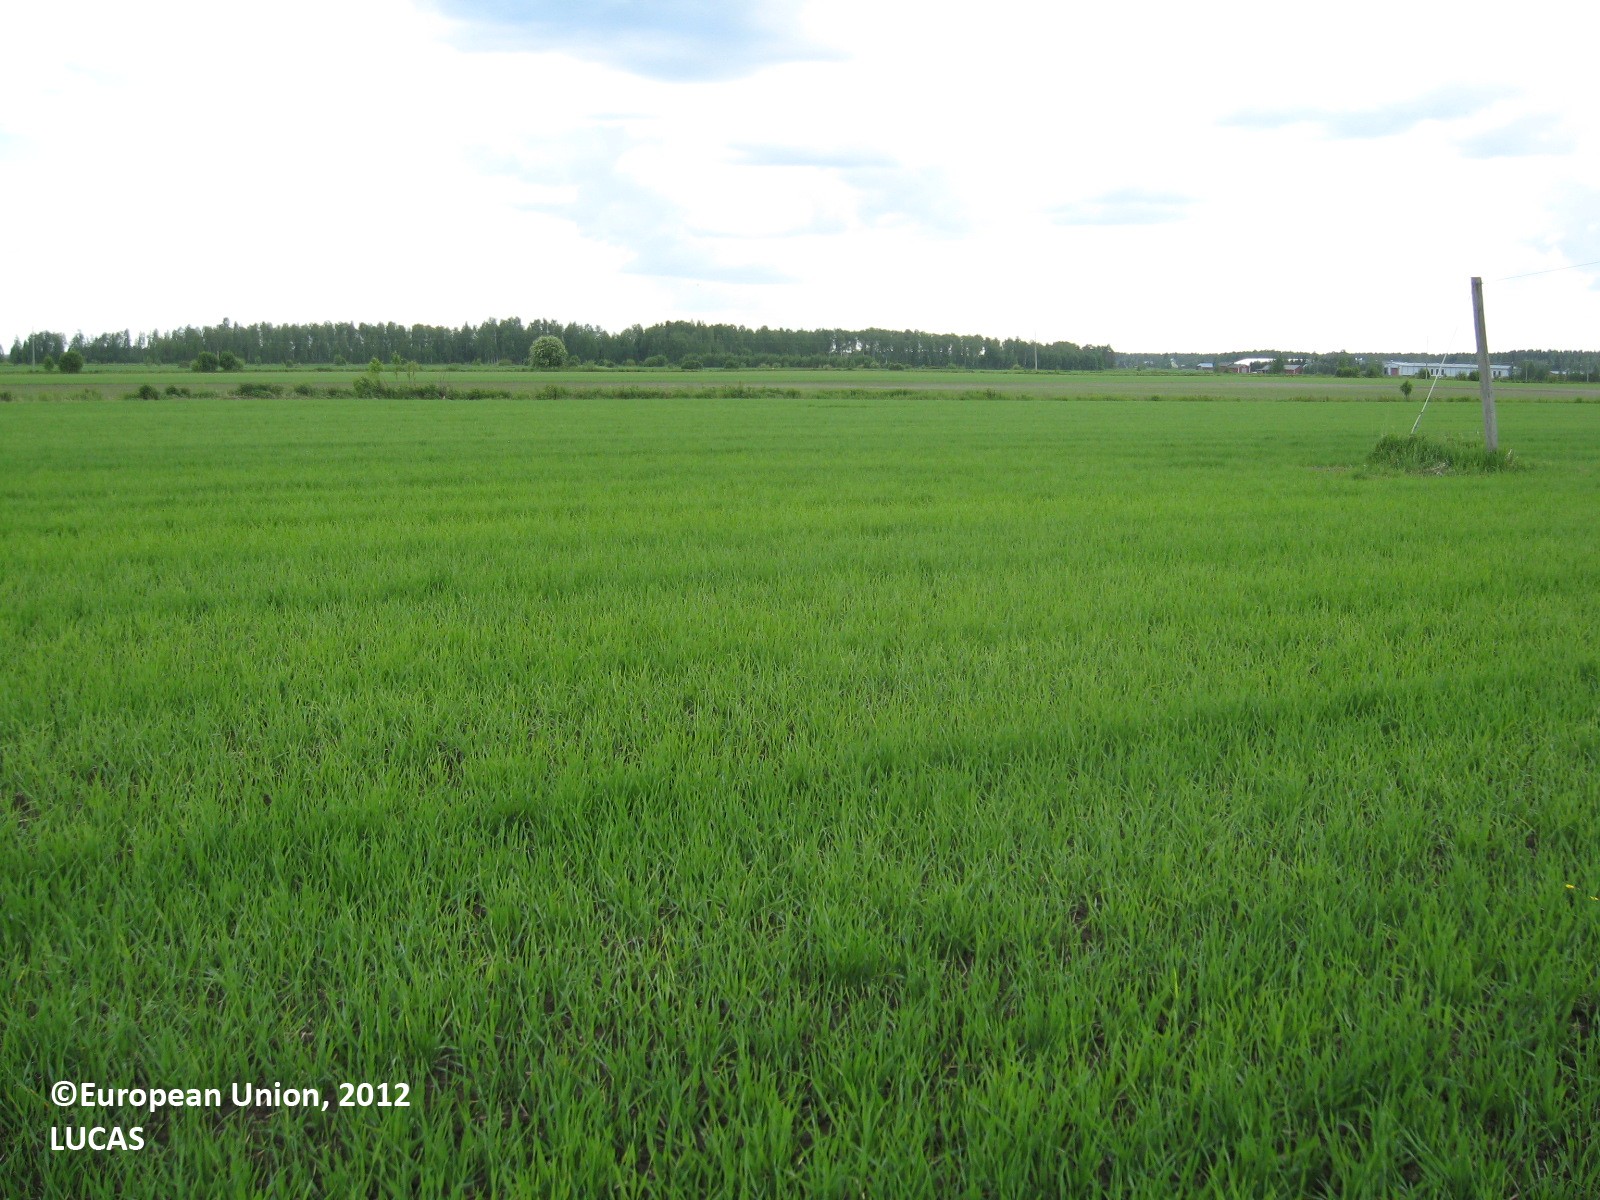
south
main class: Cropland
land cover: Barley
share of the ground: > 75 %
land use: Agriculture (excluding fallow land and kitchen gardens)
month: June
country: FI
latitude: 63.0658
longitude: 22.8590
